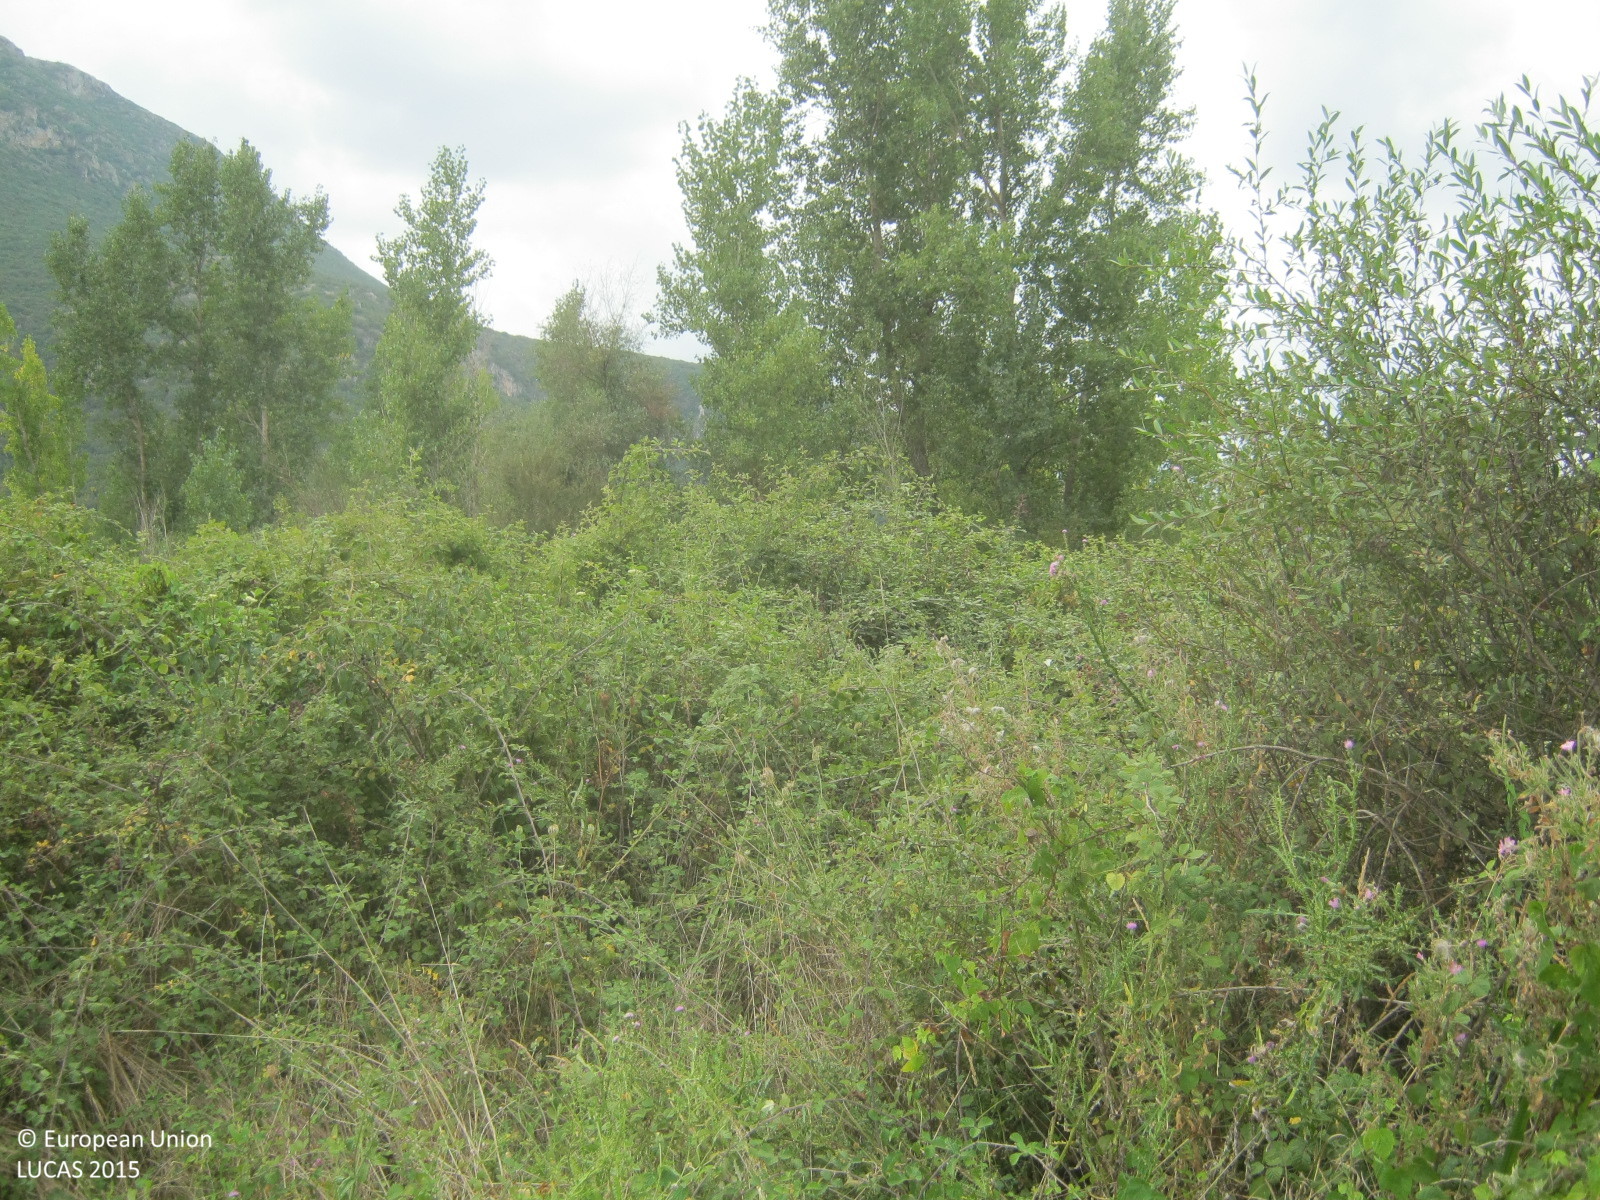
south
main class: Grassland
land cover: Grassland with sparse tree/shrub cover
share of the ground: > 75 %
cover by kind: herbaceous plants 90 %, broadleaved forest trees 5 %, shrubs 5 %
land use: Semi-natural and natural areas not in use
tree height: > 5 m
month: September
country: GR
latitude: 37.8162
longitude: 22.0848
